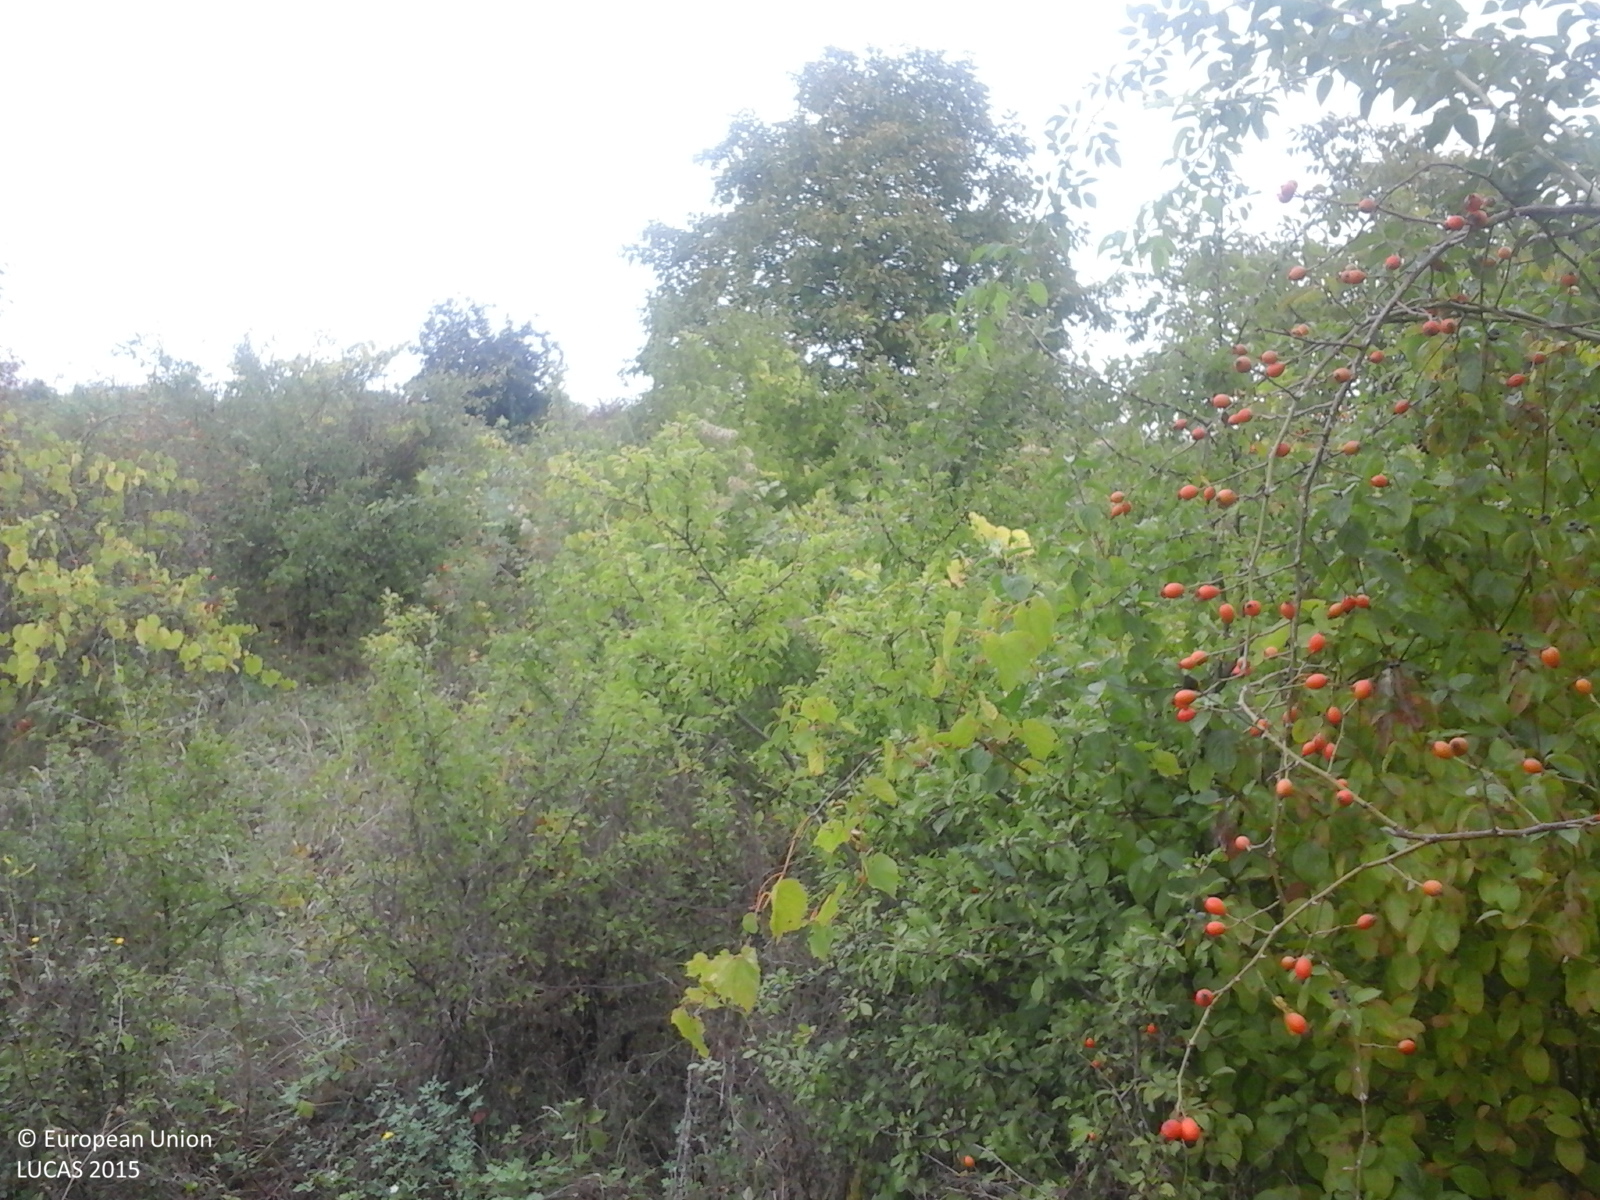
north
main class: Cropland
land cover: Other fruit trees and berries
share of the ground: > 75 %
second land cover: Grassland without tree/shrub cover
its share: > 75 %
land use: Agriculture (excluding fallow land and kitchen gardens)
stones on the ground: < 10 %
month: September
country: RO
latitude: 47.2494
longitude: 22.0594
